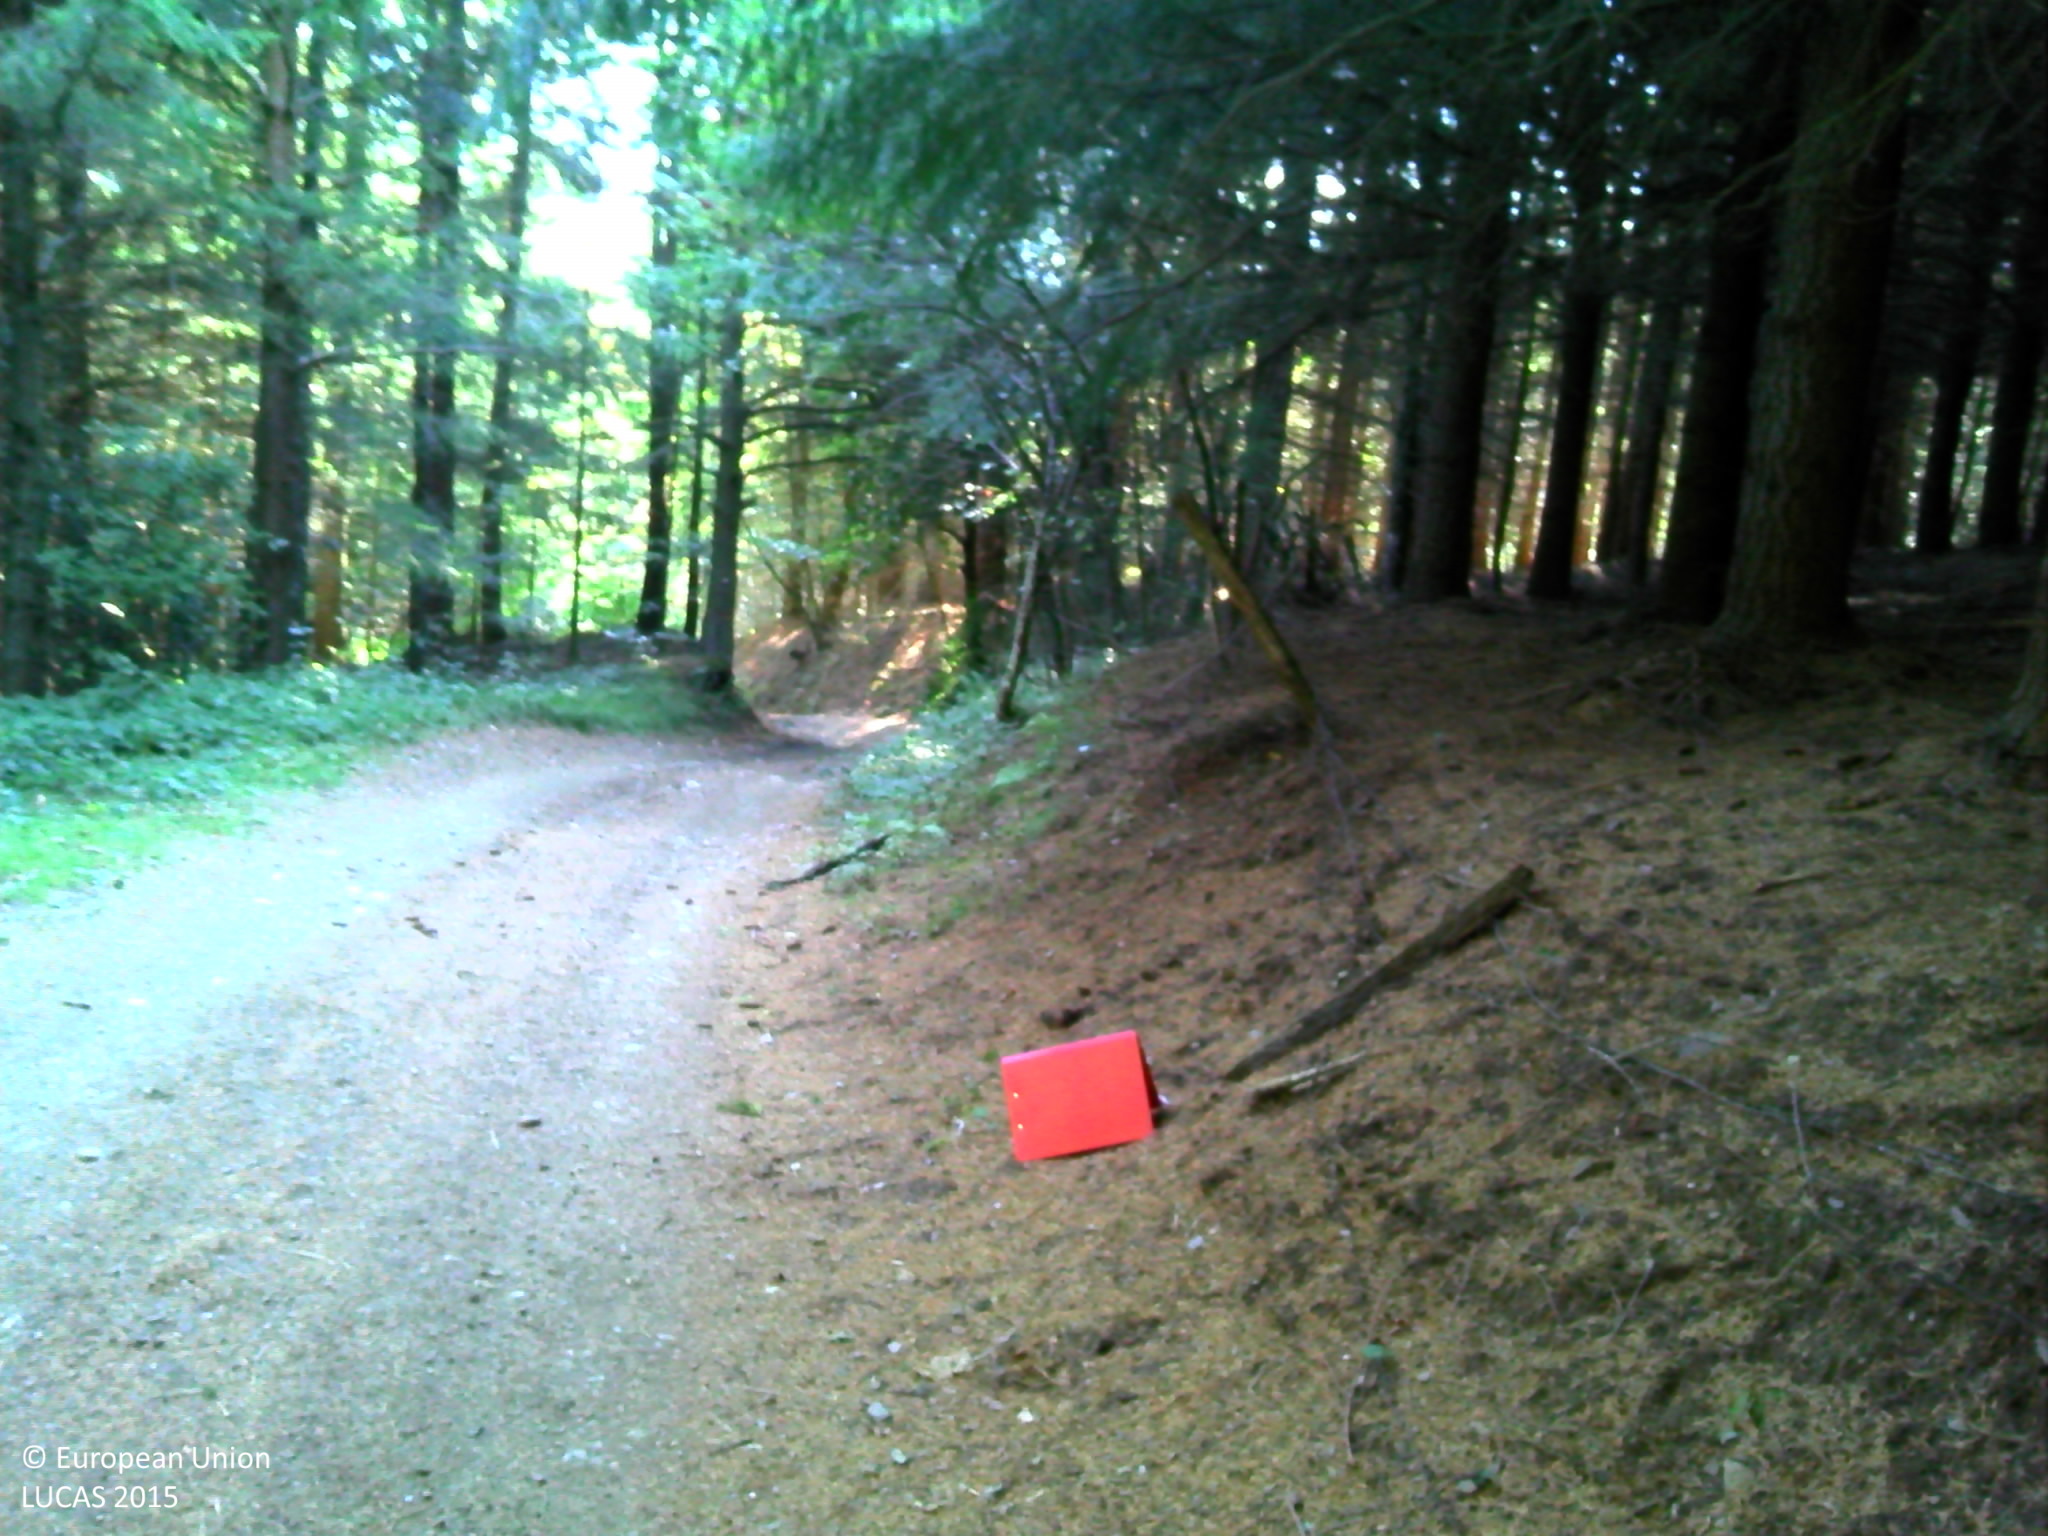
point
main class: Woodland
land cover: Spruce dominated coniferous woodland
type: alpine coniferous forest
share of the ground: > 75 %
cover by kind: coniferous forest trees 95 %, herbaceous plants 5 %
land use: Forestry
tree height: > 5 m
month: September
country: FR
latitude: 45.4190
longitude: 4.5729
